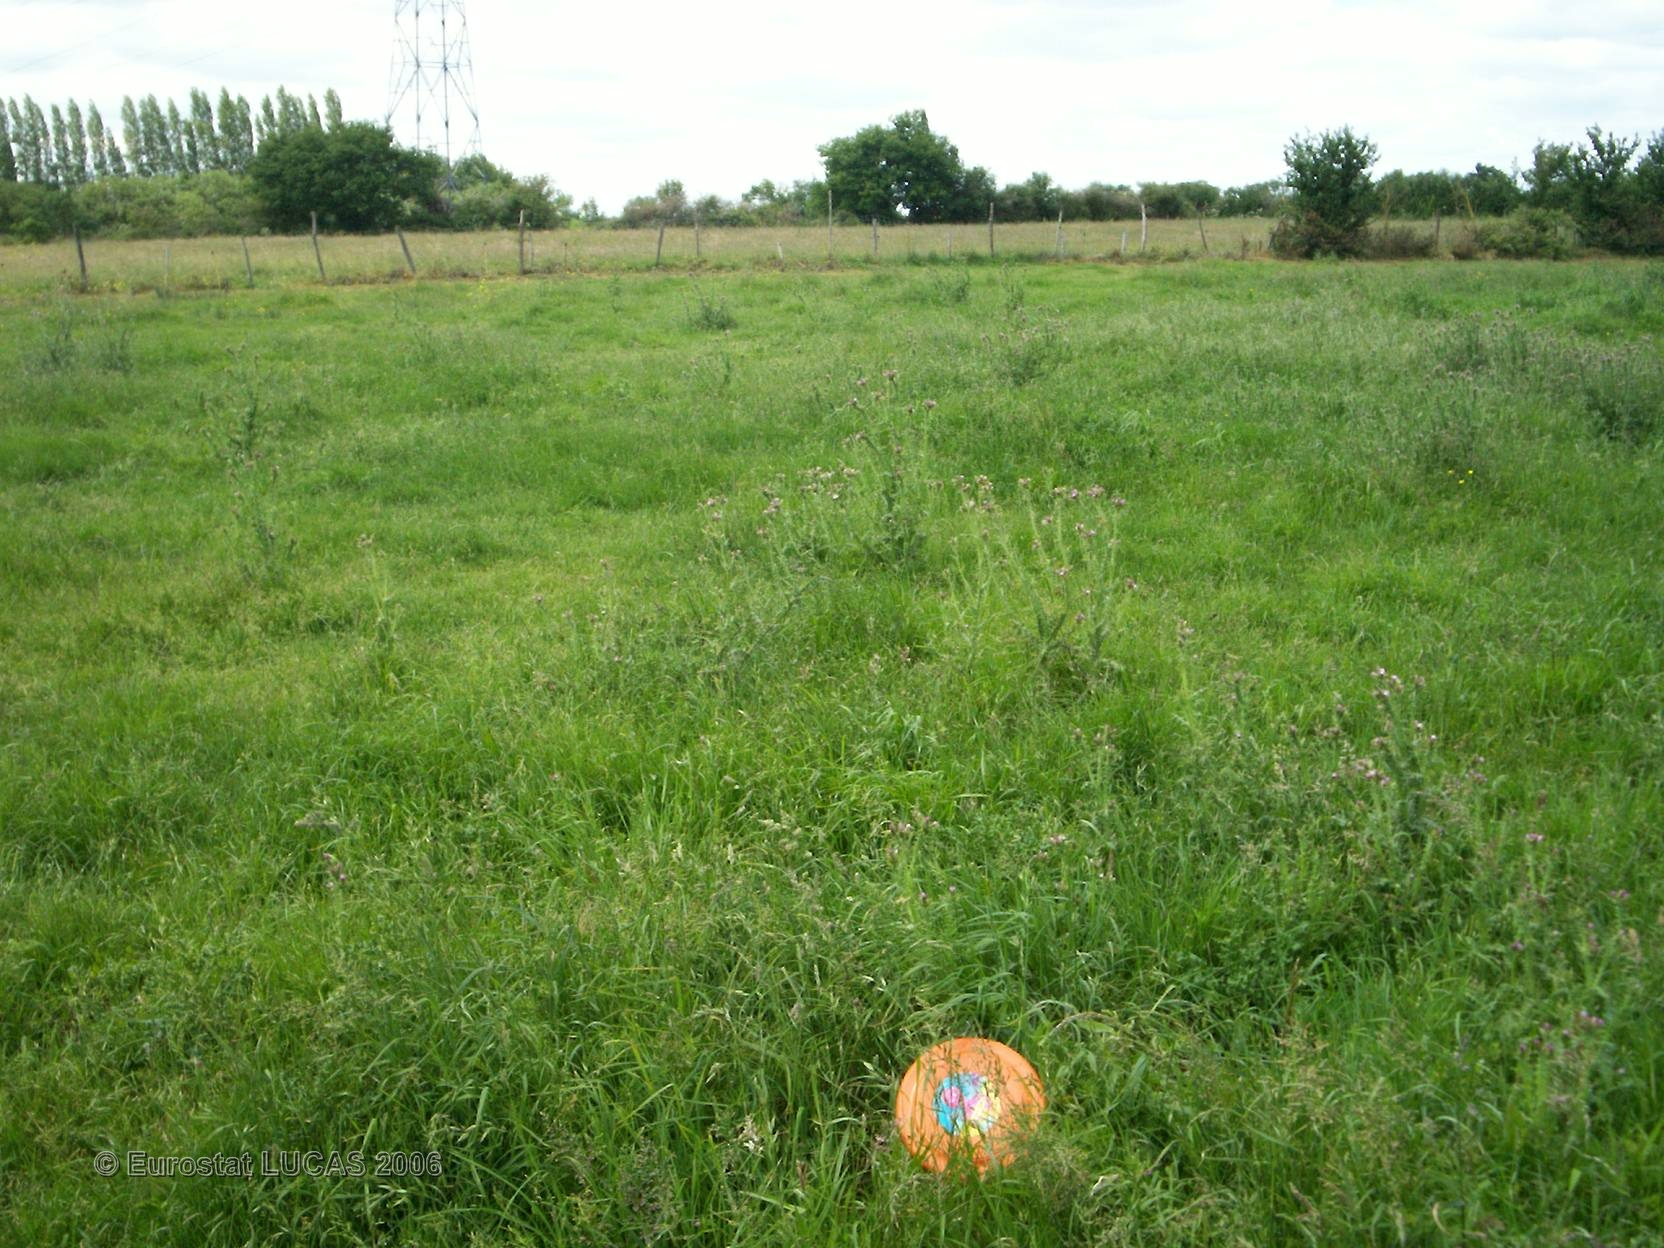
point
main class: Grassland
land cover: Grassland without tree/shrub cover
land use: Agriculture (excluding fallow land and kitchen gardens)
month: May
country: FR
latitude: 47.4243
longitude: -1.1065
